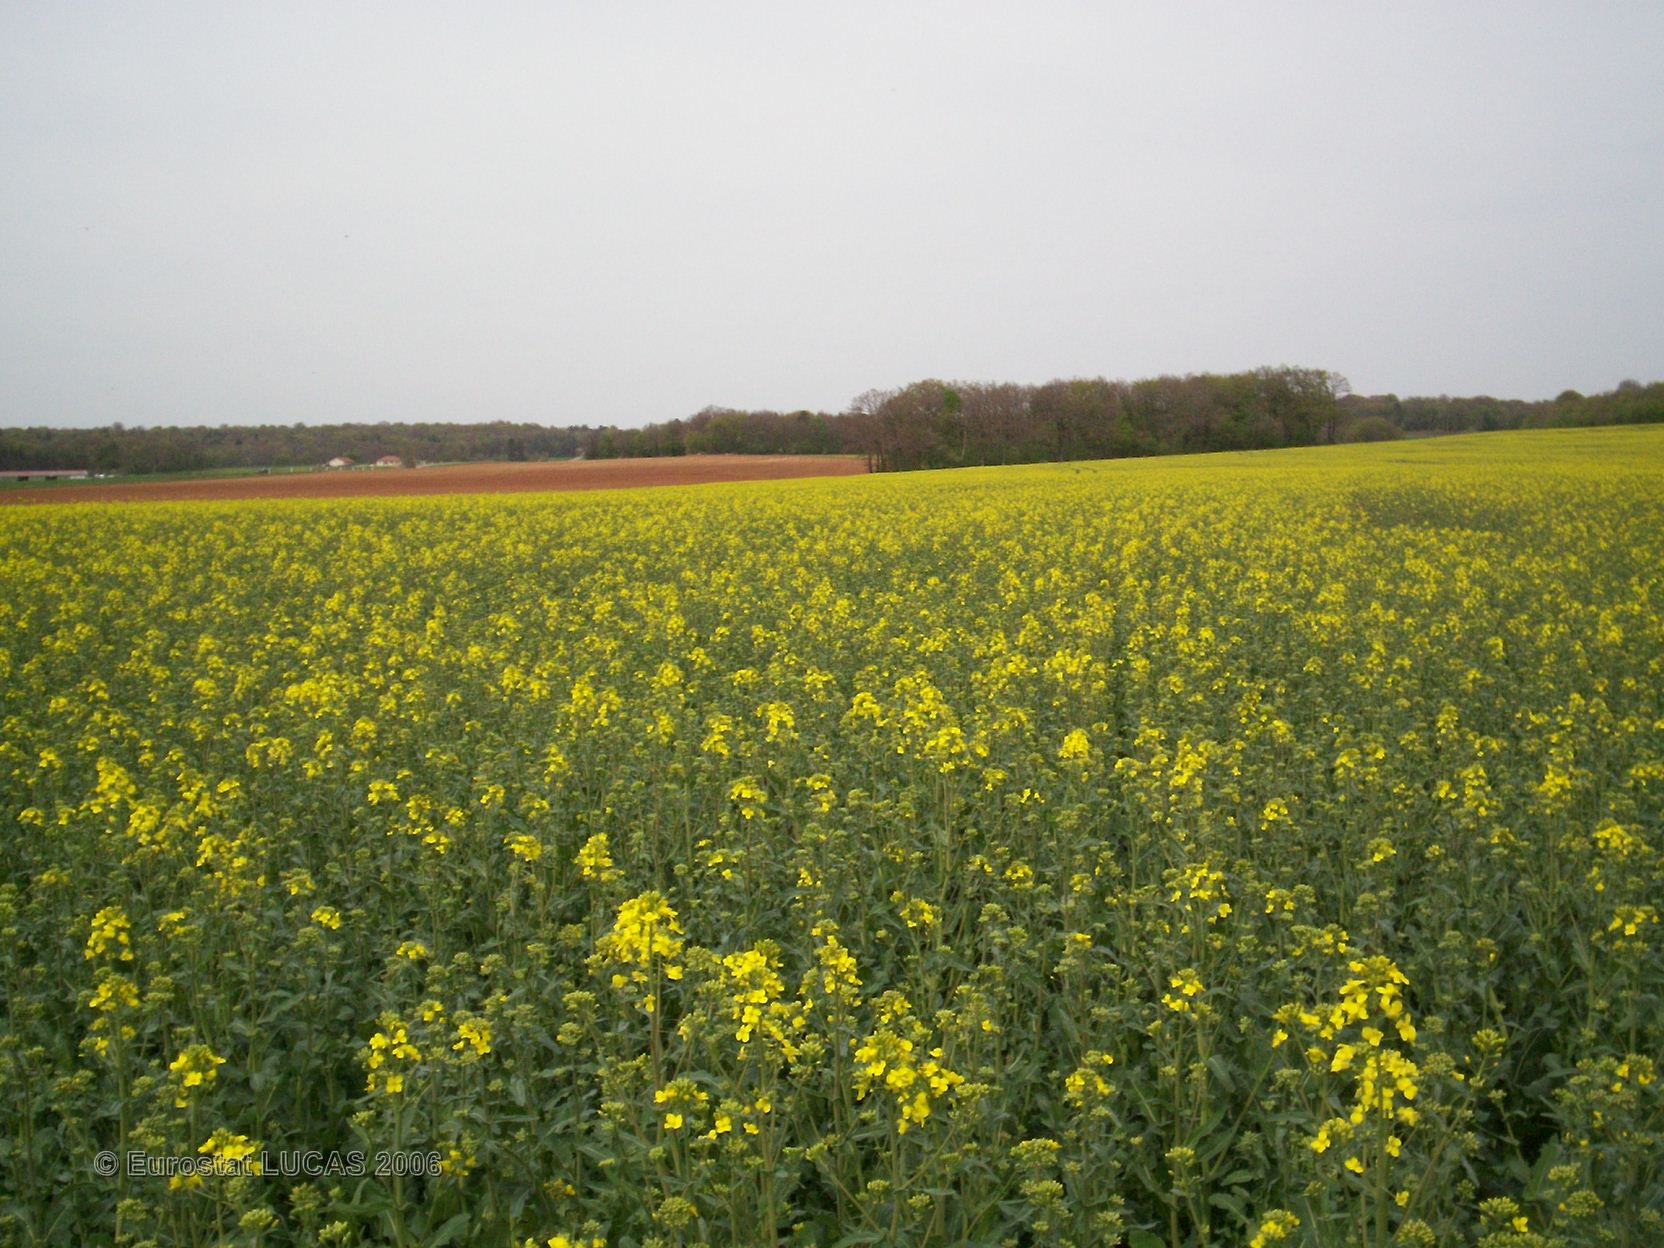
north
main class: Cropland
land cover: Rape and turnip rape
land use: Agriculture (excluding fallow land and kitchen gardens)
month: May
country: FR
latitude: 47.6906
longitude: 4.5228
